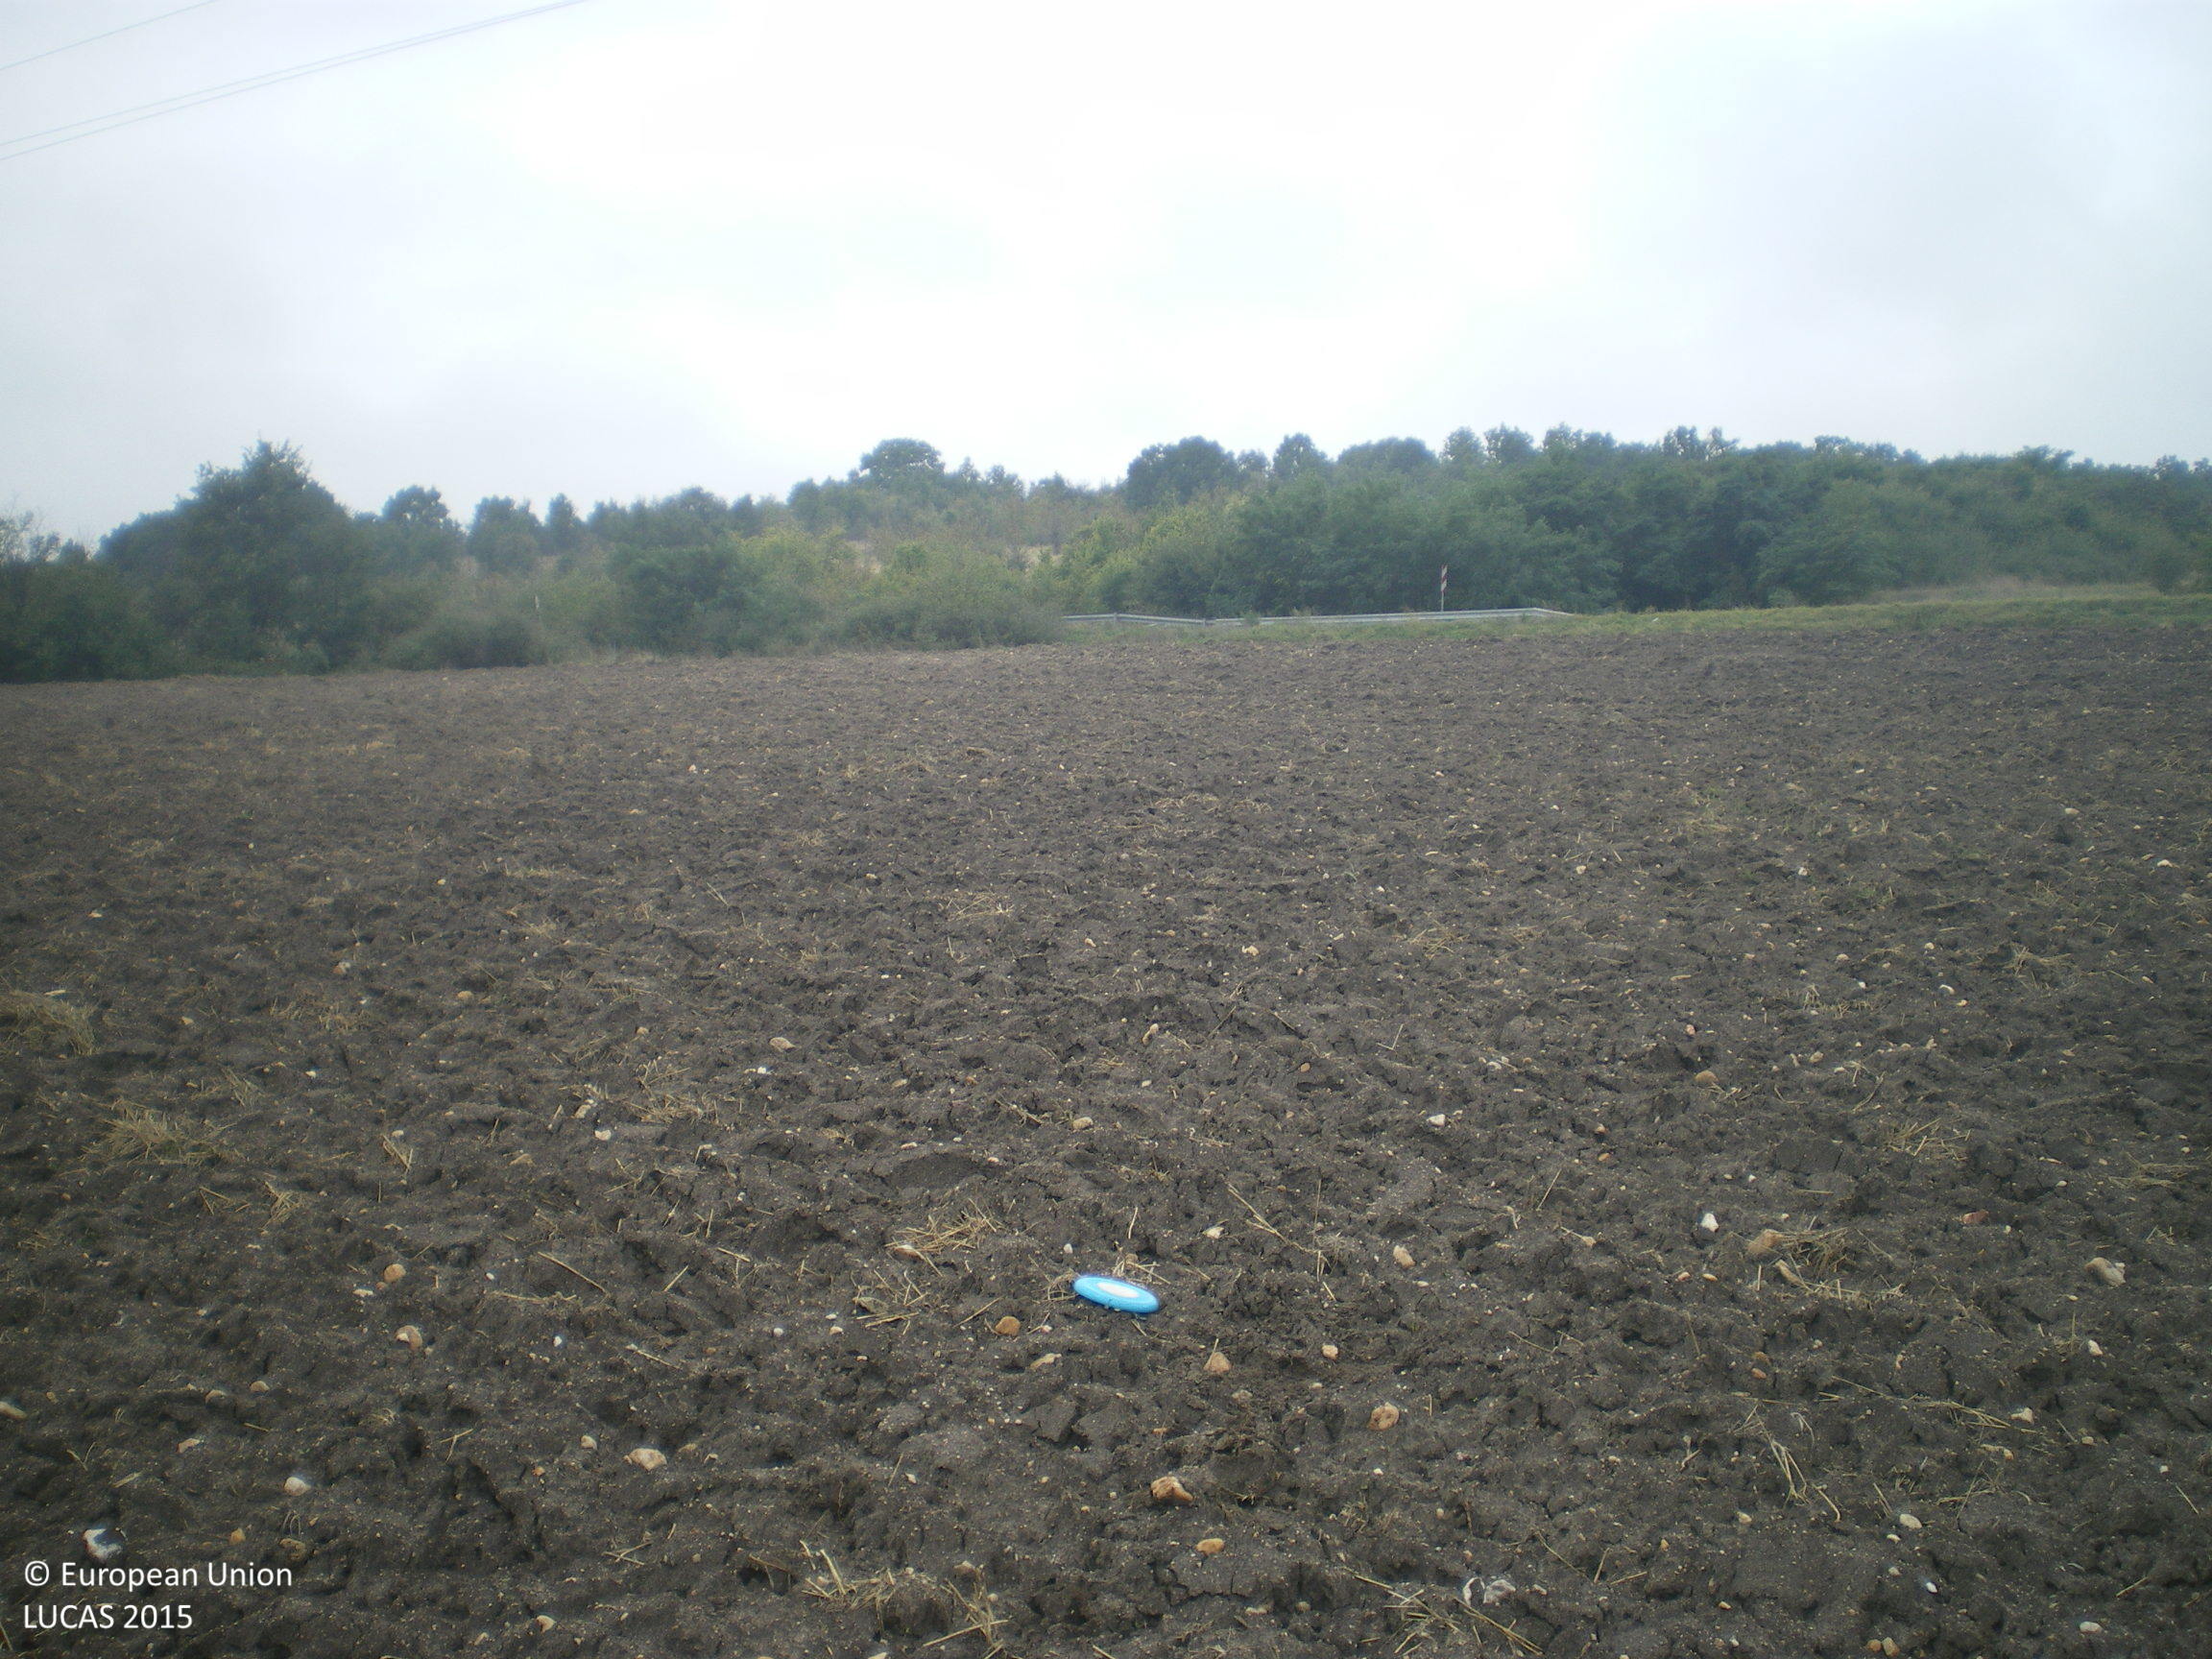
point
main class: Cropland
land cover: Common wheat
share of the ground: < 10 %
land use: Agriculture (excluding fallow land and kitchen gardens)
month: October
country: BG
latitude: 41.8184
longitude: 26.1960
